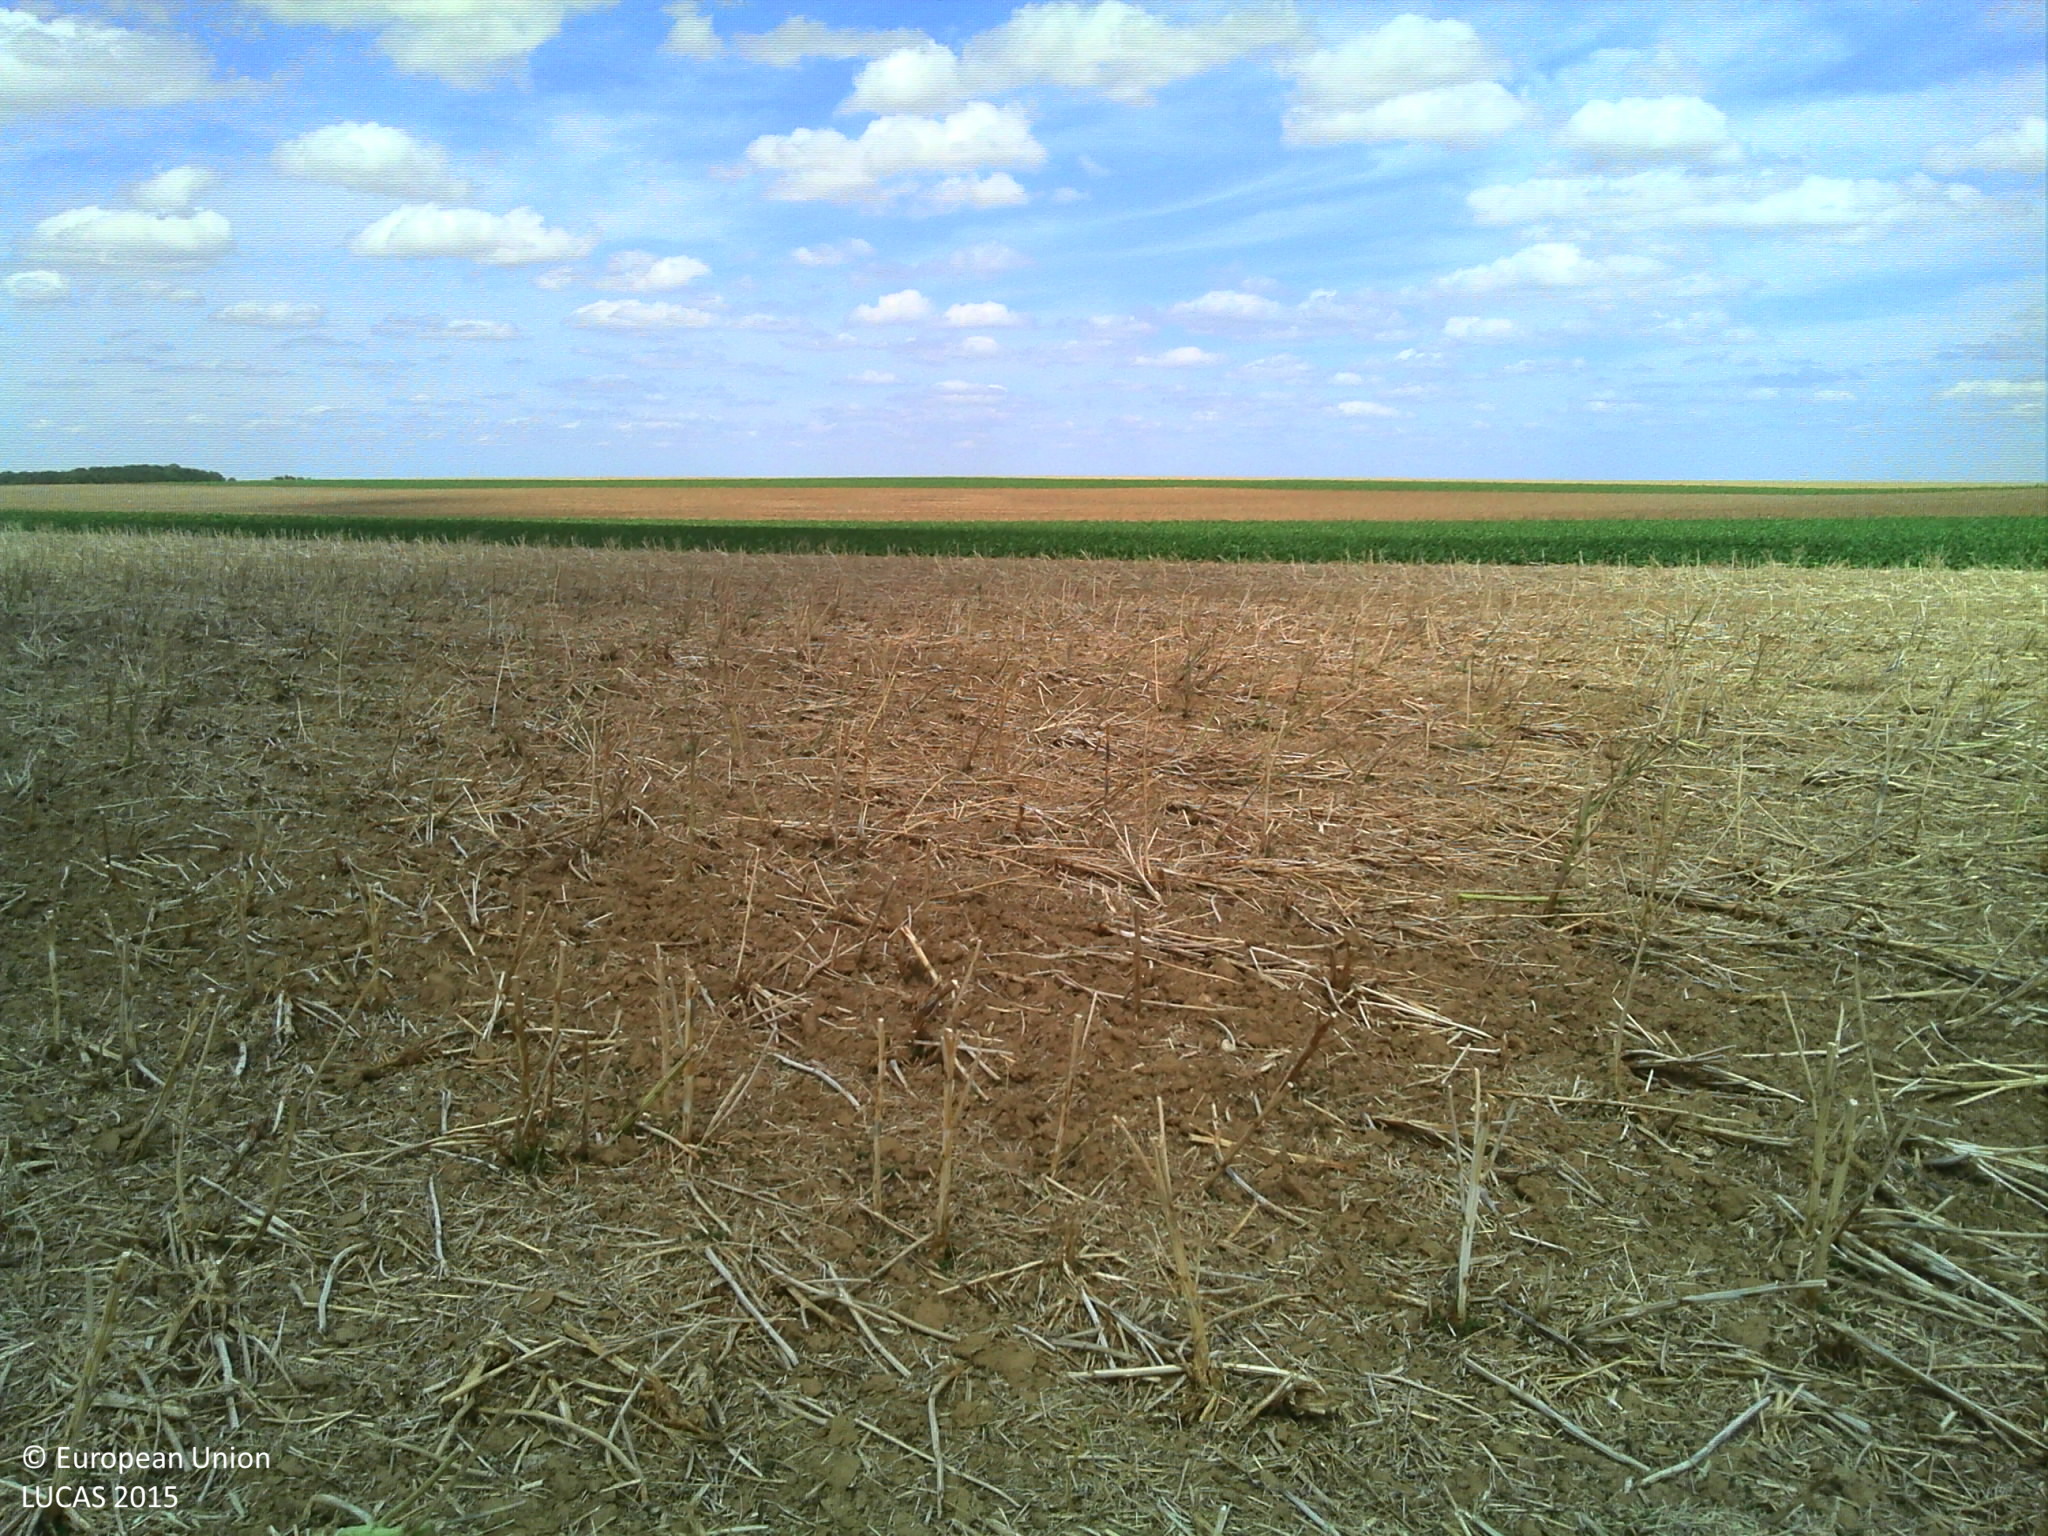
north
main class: Cropland
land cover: Rape and turnip rape
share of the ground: > 75 %
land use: Agriculture (excluding fallow land and kitchen gardens)
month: August
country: FR
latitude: 48.6418
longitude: 3.4384
